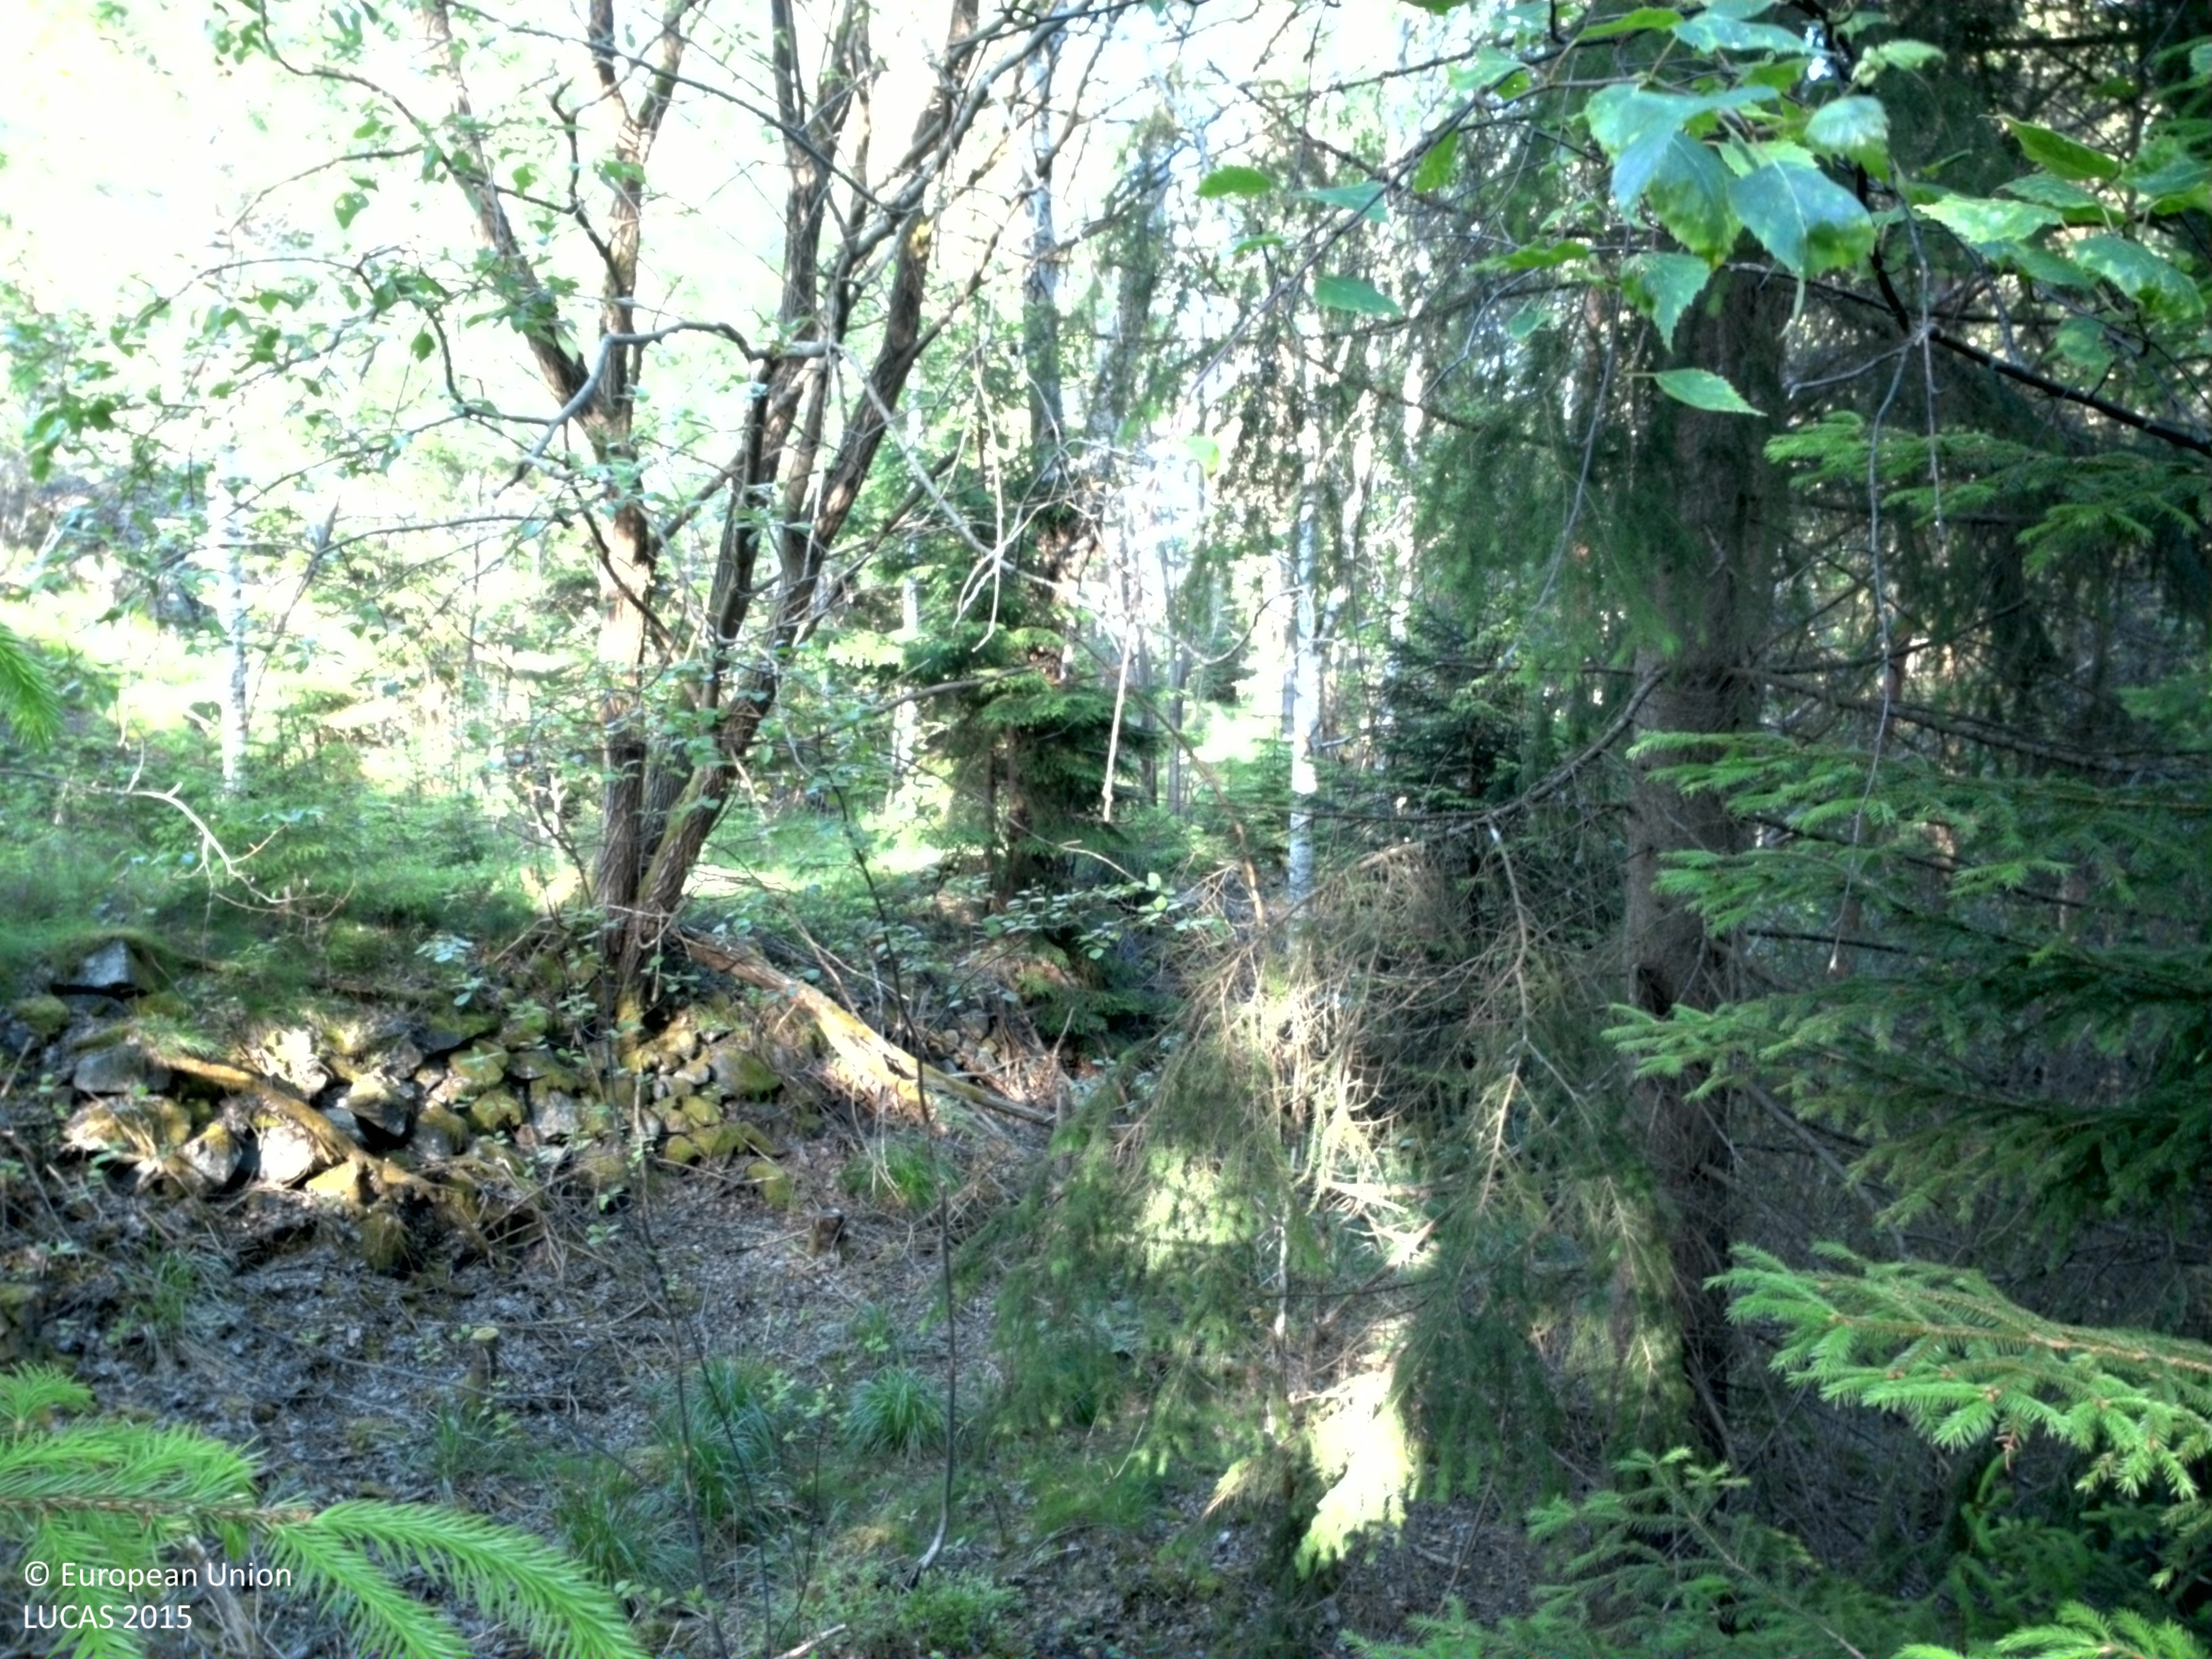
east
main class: Woodland
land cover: Spruce dominated mixed woodland
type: boreal forest
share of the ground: 50 - 75 %
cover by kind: coniferous forest trees 50 %, broadleaved forest trees 25 %, herbaceous plants 20 %, shrubs 5 %
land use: Forestry
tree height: > 5 m
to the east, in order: Spruce dominated mixed woodland; Tracks; Spruce dominated mixed woodland; Pine dominated mixed woodland; Pine dominated coniferous woodland; Tracks; Pine dominated coniferous woodland; Rocks and stones; Grass margins; Paved roads, cycling and walking lanes
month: June
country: SE
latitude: 58.6636
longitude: 14.5960
